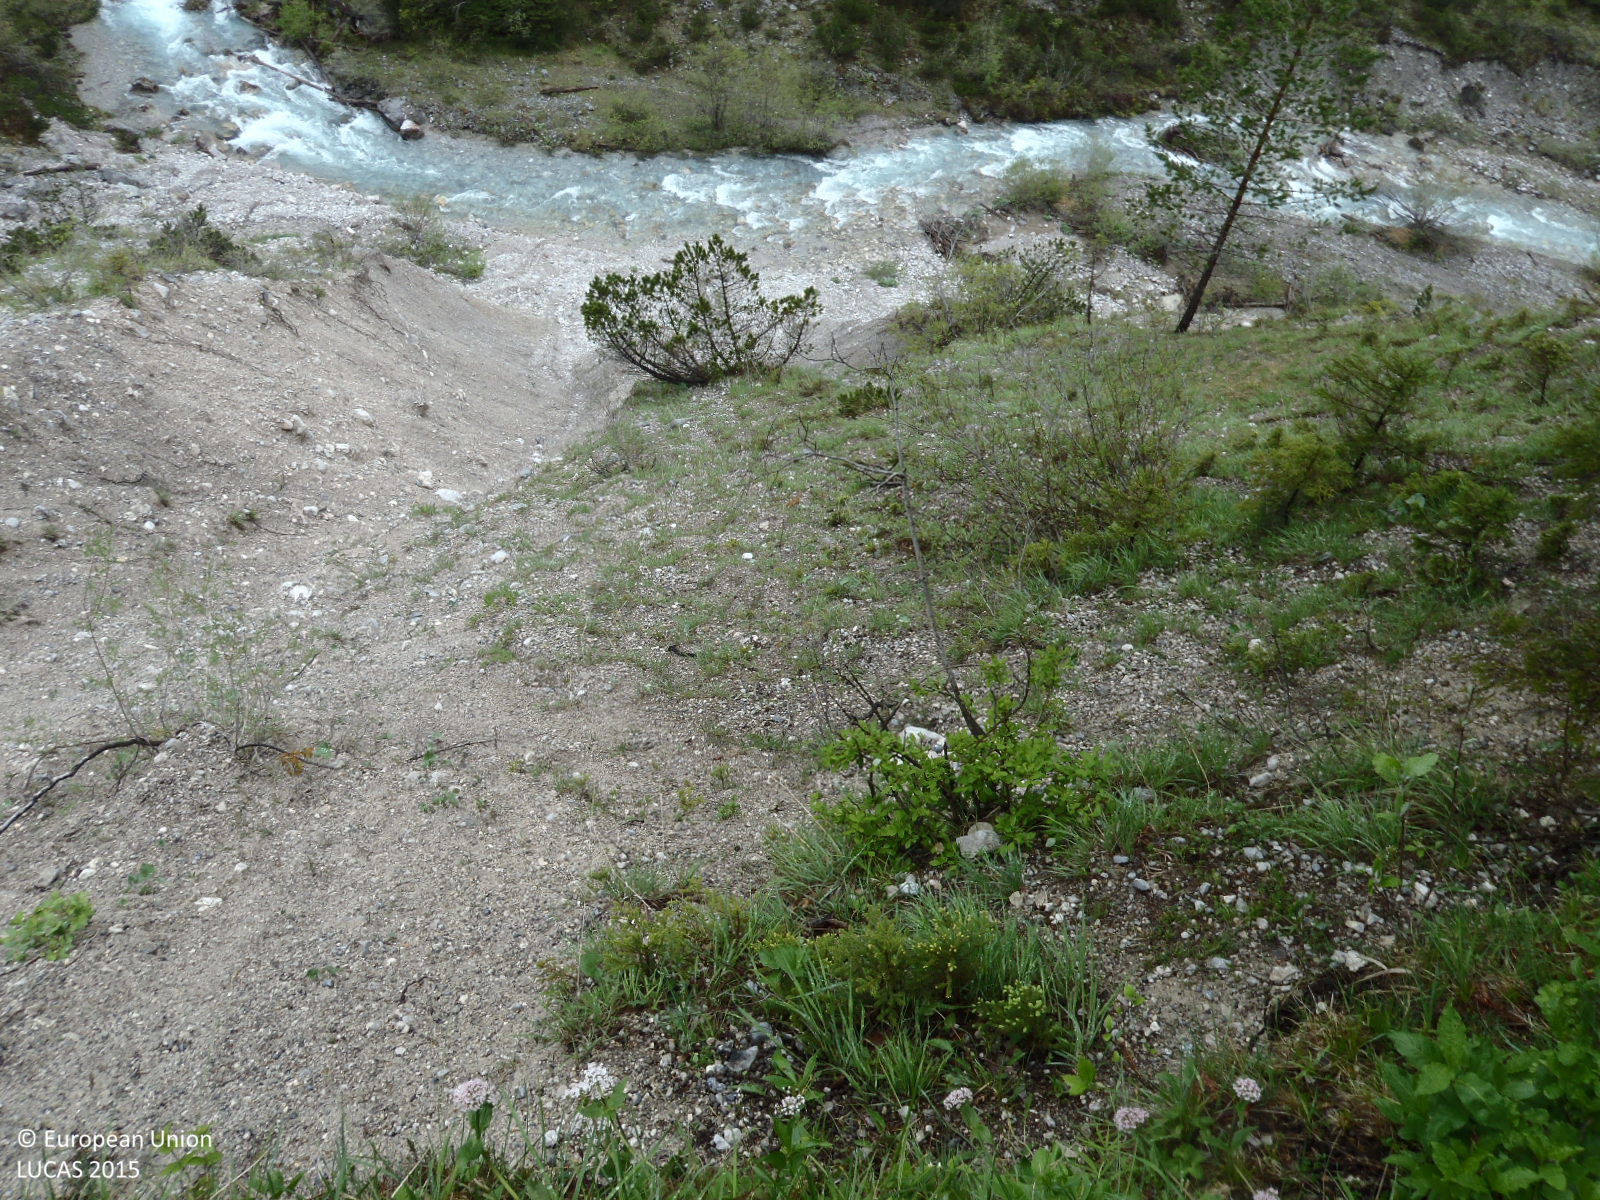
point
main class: Grassland
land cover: Grassland with sparse tree/shrub cover
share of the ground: > 75 %
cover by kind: herbaceous plants 55 %, unconsolidated bare surface 35 %, coniferous forest trees 5 %, shrubs 5 %
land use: Semi-natural and natural areas not in use
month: May
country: AT
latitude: 47.4382
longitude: 11.5766
